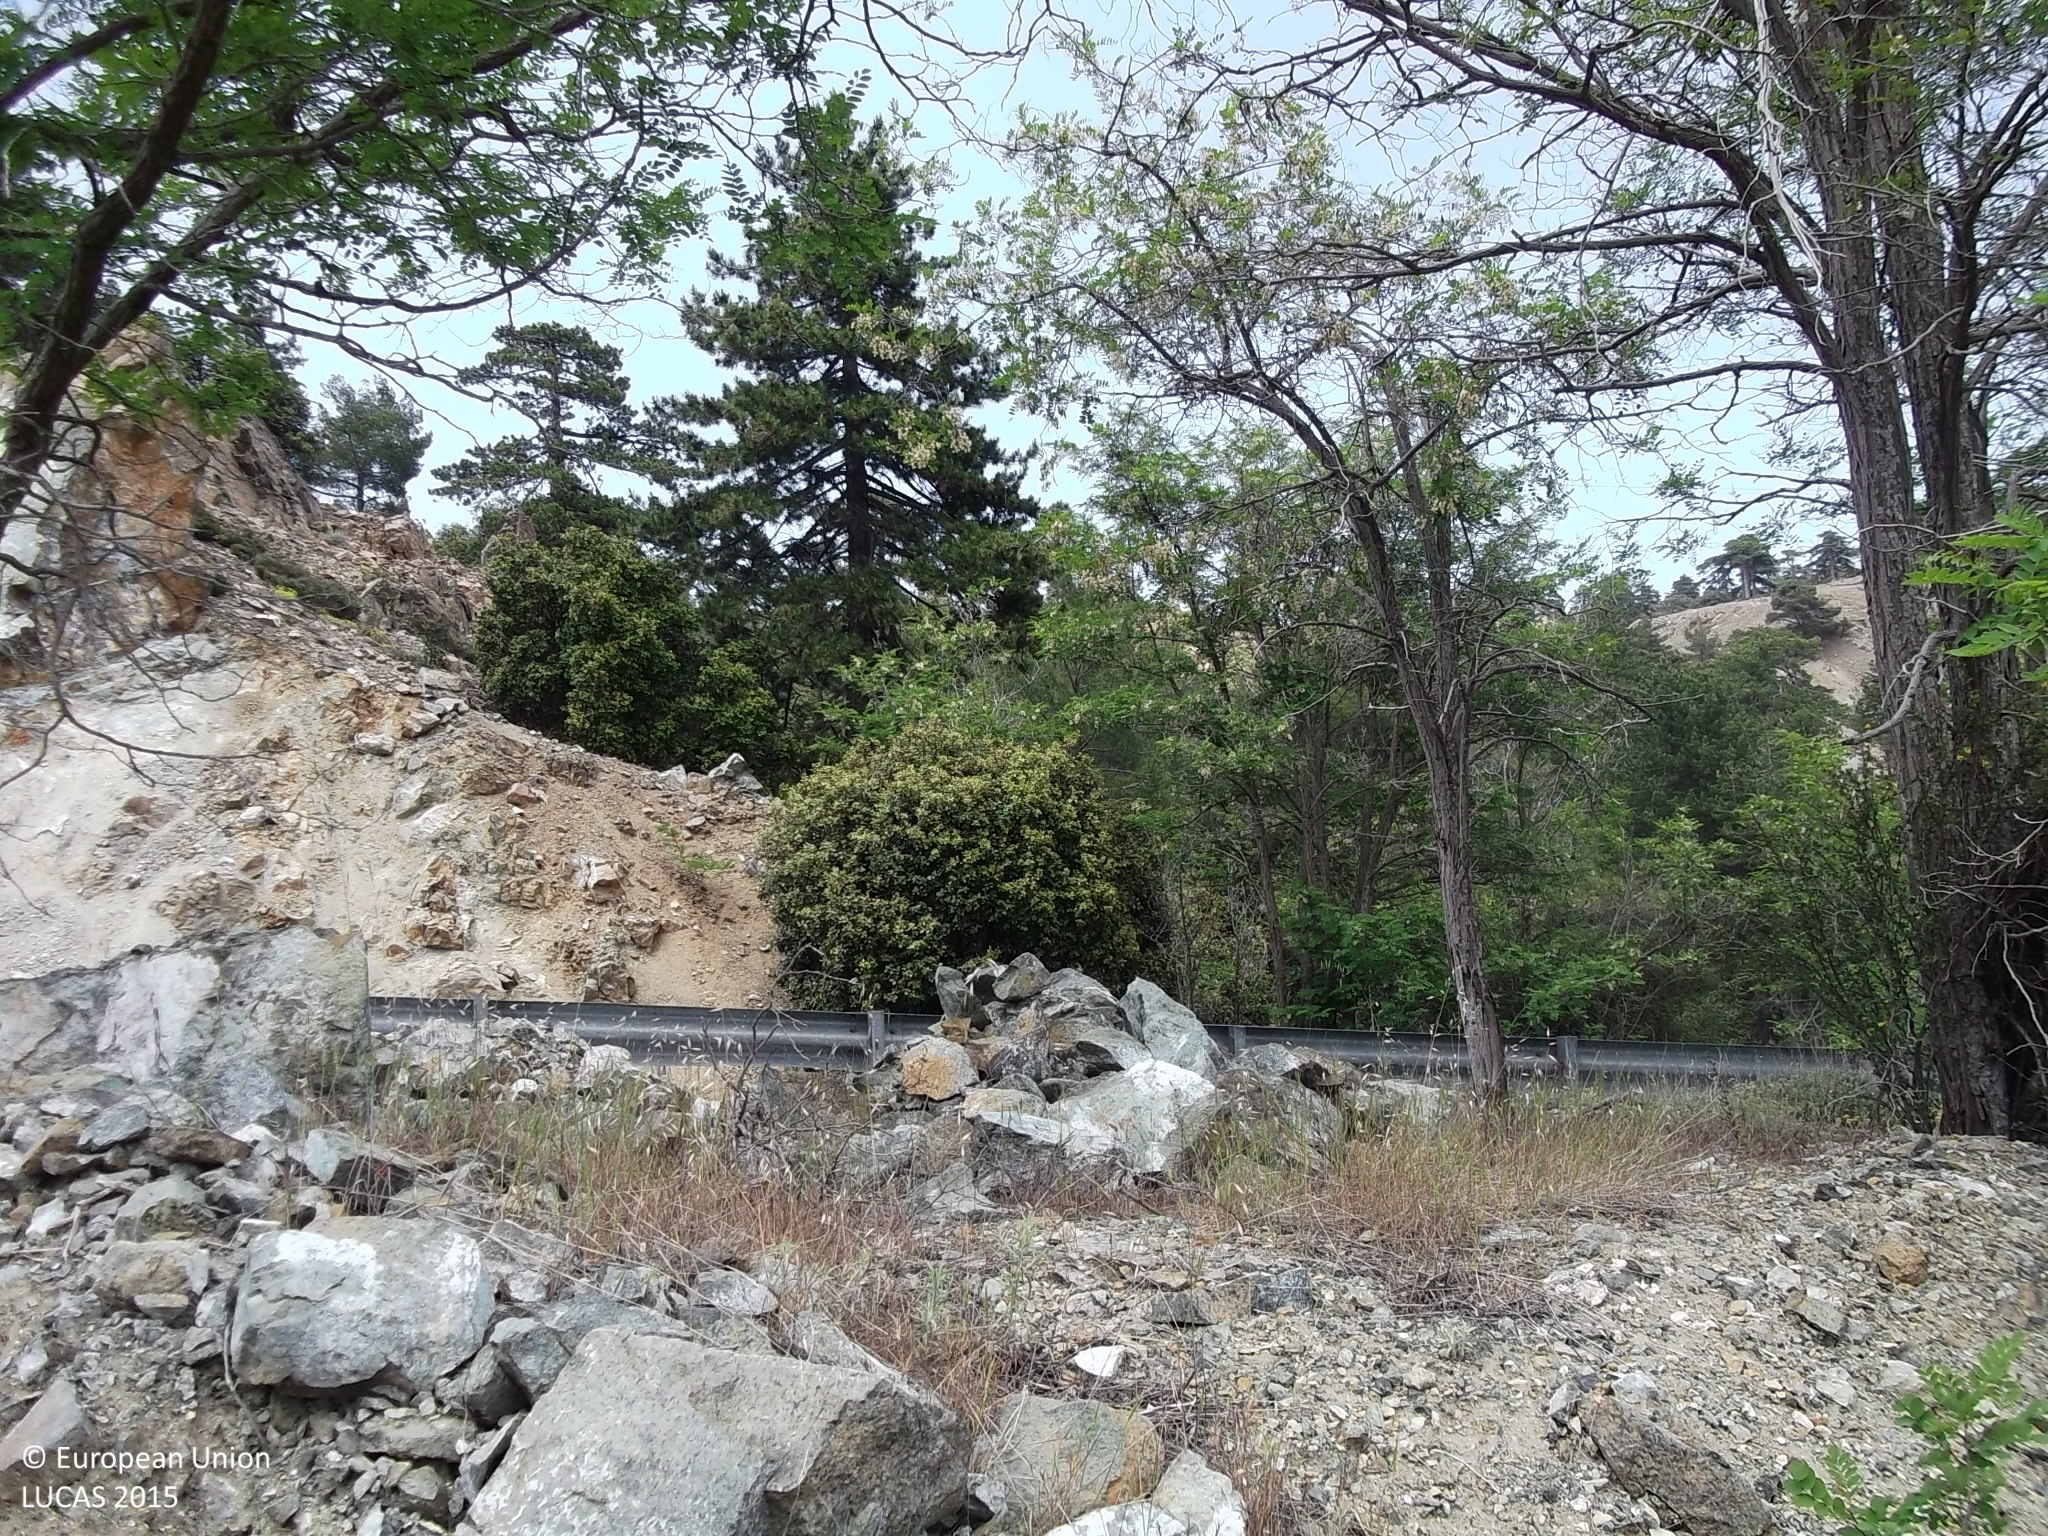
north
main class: Woodland
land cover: Pine dominated coniferous woodland
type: coniferous forest of the mediterranean region
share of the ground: 10 - 25 %
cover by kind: consolidated bare surface 35 %, unconsolidated bare surface 25 %, coniferous forest trees 20 %, shrubs 20 %
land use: Forestry
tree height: > 5 m
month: June
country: CY
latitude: 34.9305
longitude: 32.9059
